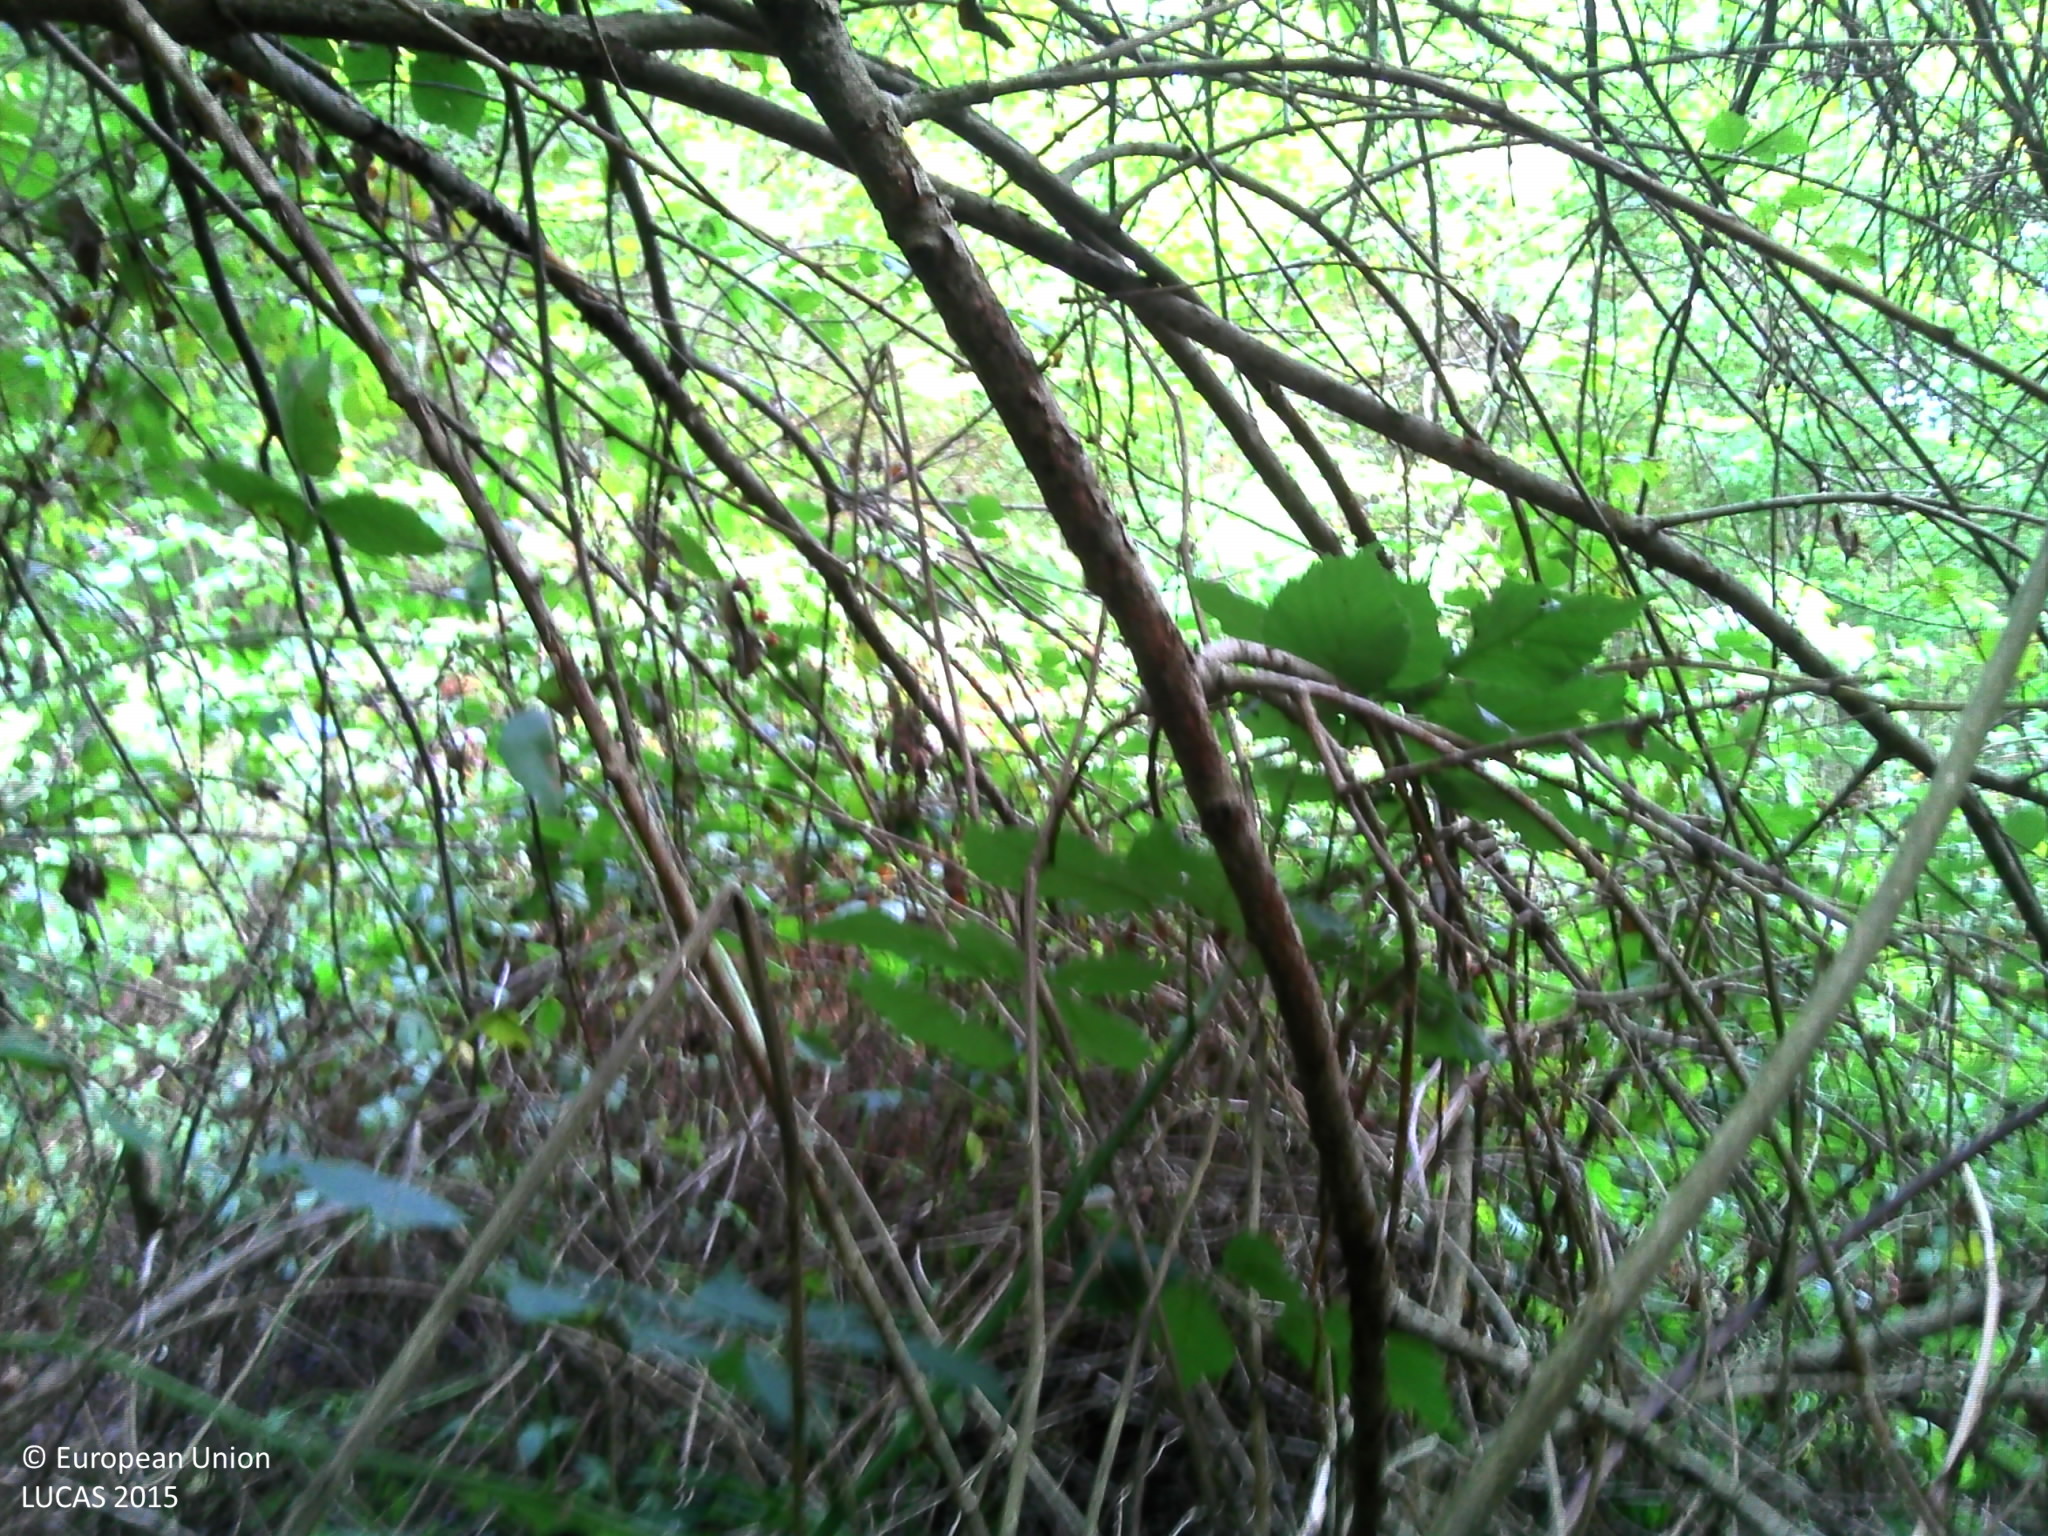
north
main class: Woodland
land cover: Broadleaved woodland
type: mesophytic deciduous forest
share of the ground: > 75 %
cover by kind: broadleaved forest trees 85 %, shrubs 15 %
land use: Forestry
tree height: > 5 m
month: September
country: FR
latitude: 47.3016
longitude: 4.3253
